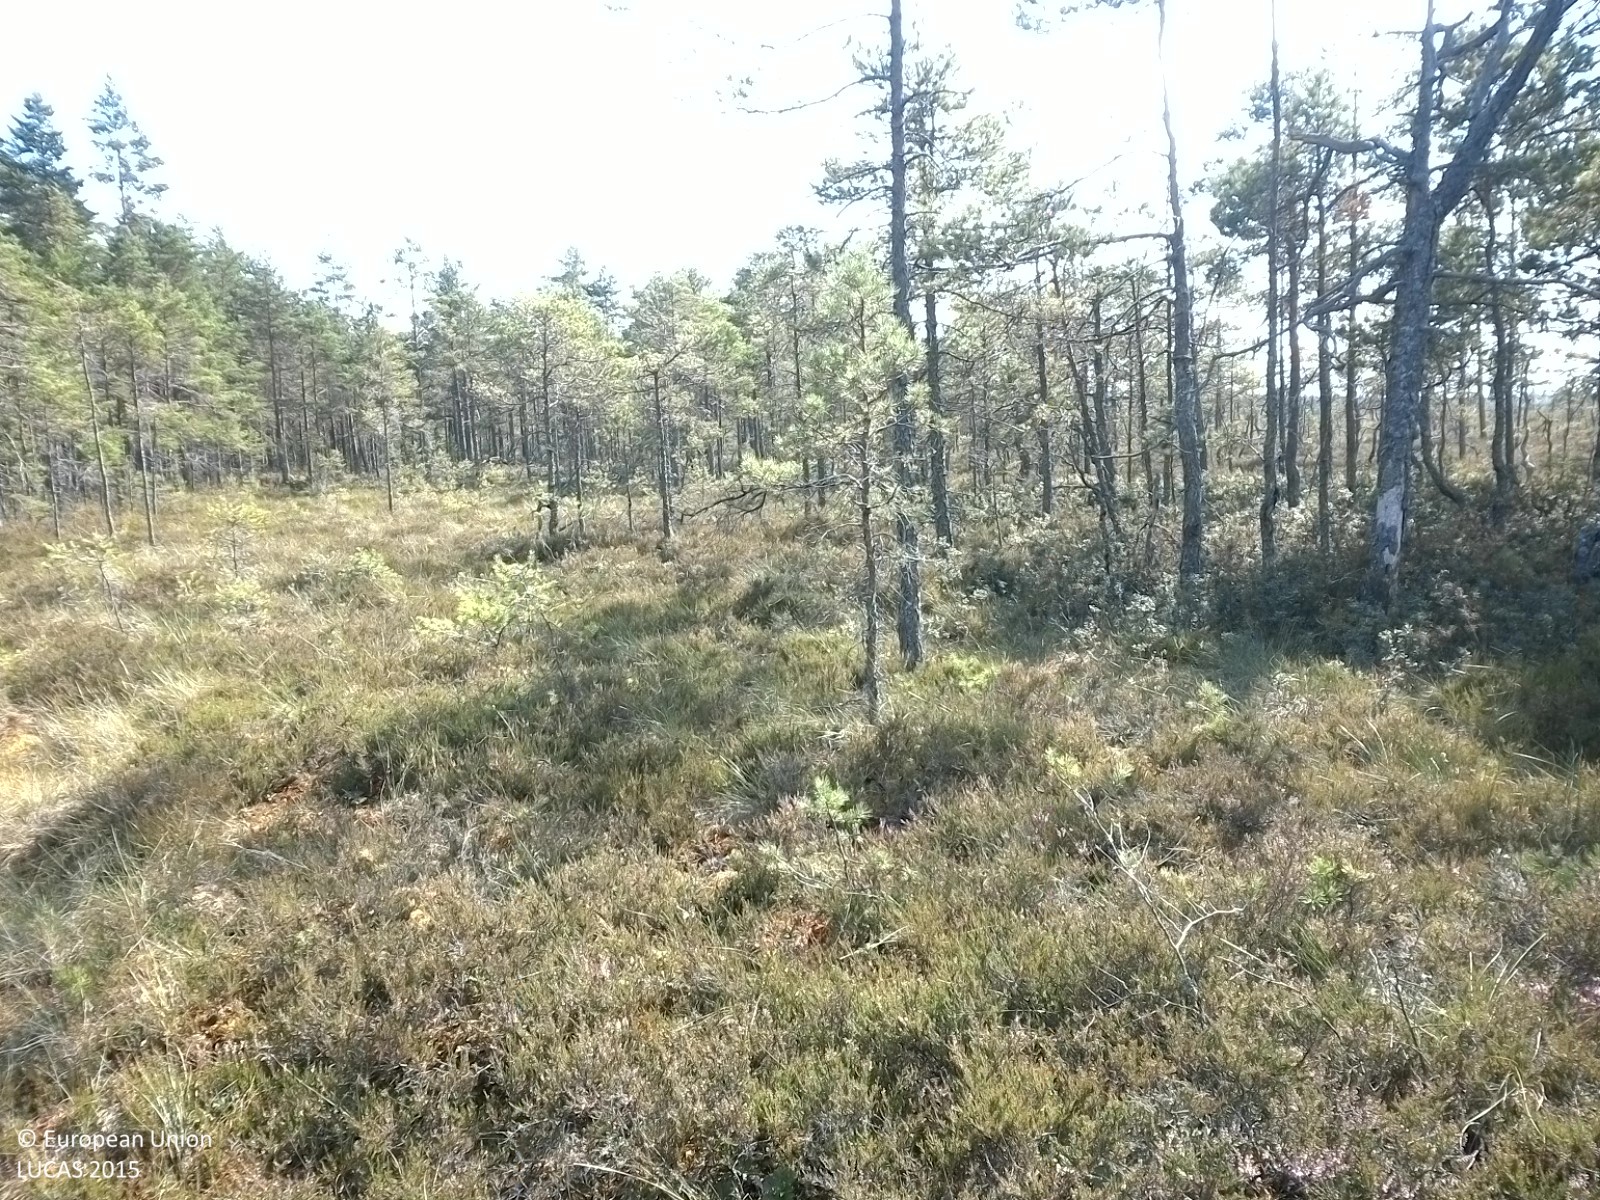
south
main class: Woodland
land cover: Pine dominated coniferous woodland
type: boreal forest
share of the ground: 10 - 25 %
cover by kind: shrubs 60 %, lichens and mosses 25 %, coniferous forest trees 15 %
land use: Semi-natural and natural areas not in use
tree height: < 5 m
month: August
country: SE
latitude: 59.0727
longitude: 14.7544
